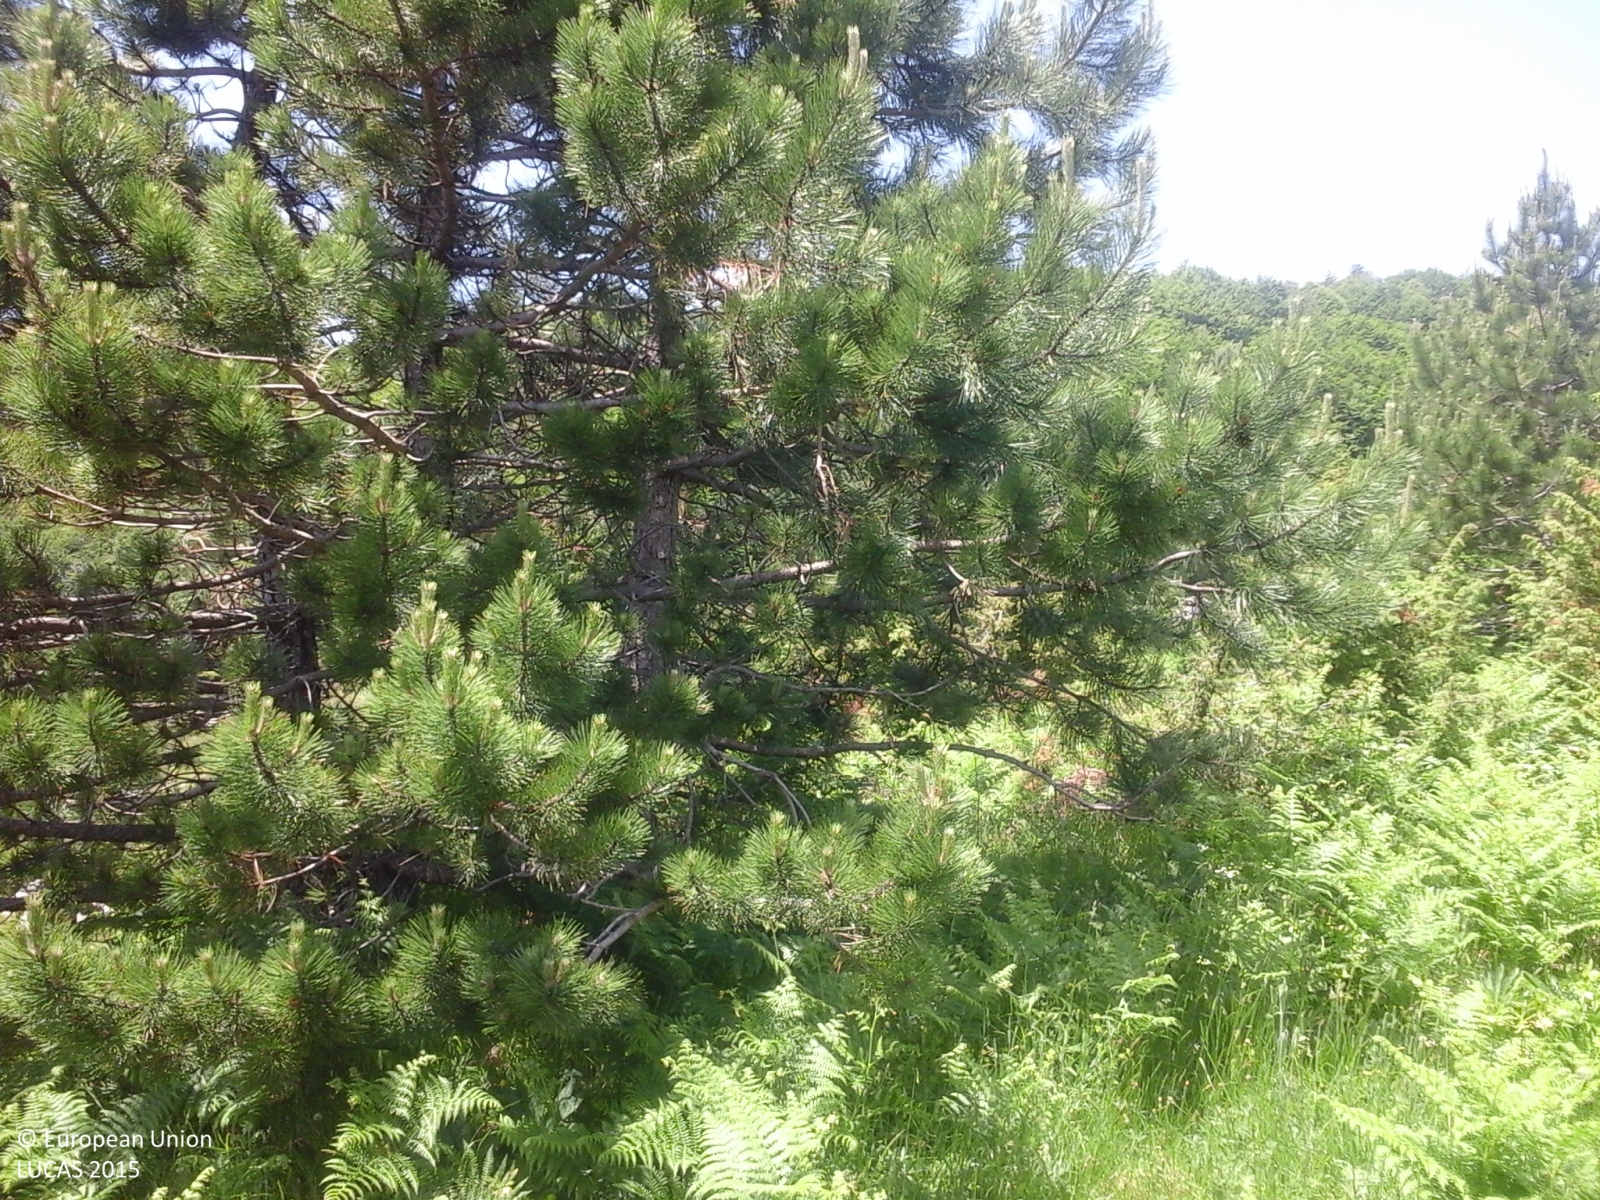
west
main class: Grassland
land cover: Grassland with sparse tree/shrub cover
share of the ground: > 75 %
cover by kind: herbaceous plants 85 %, shrubs 10 %, coniferous forest trees 5 %
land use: Semi-natural and natural areas not in use
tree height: < 5 m
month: June
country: GR
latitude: 39.9010
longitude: 21.0116
